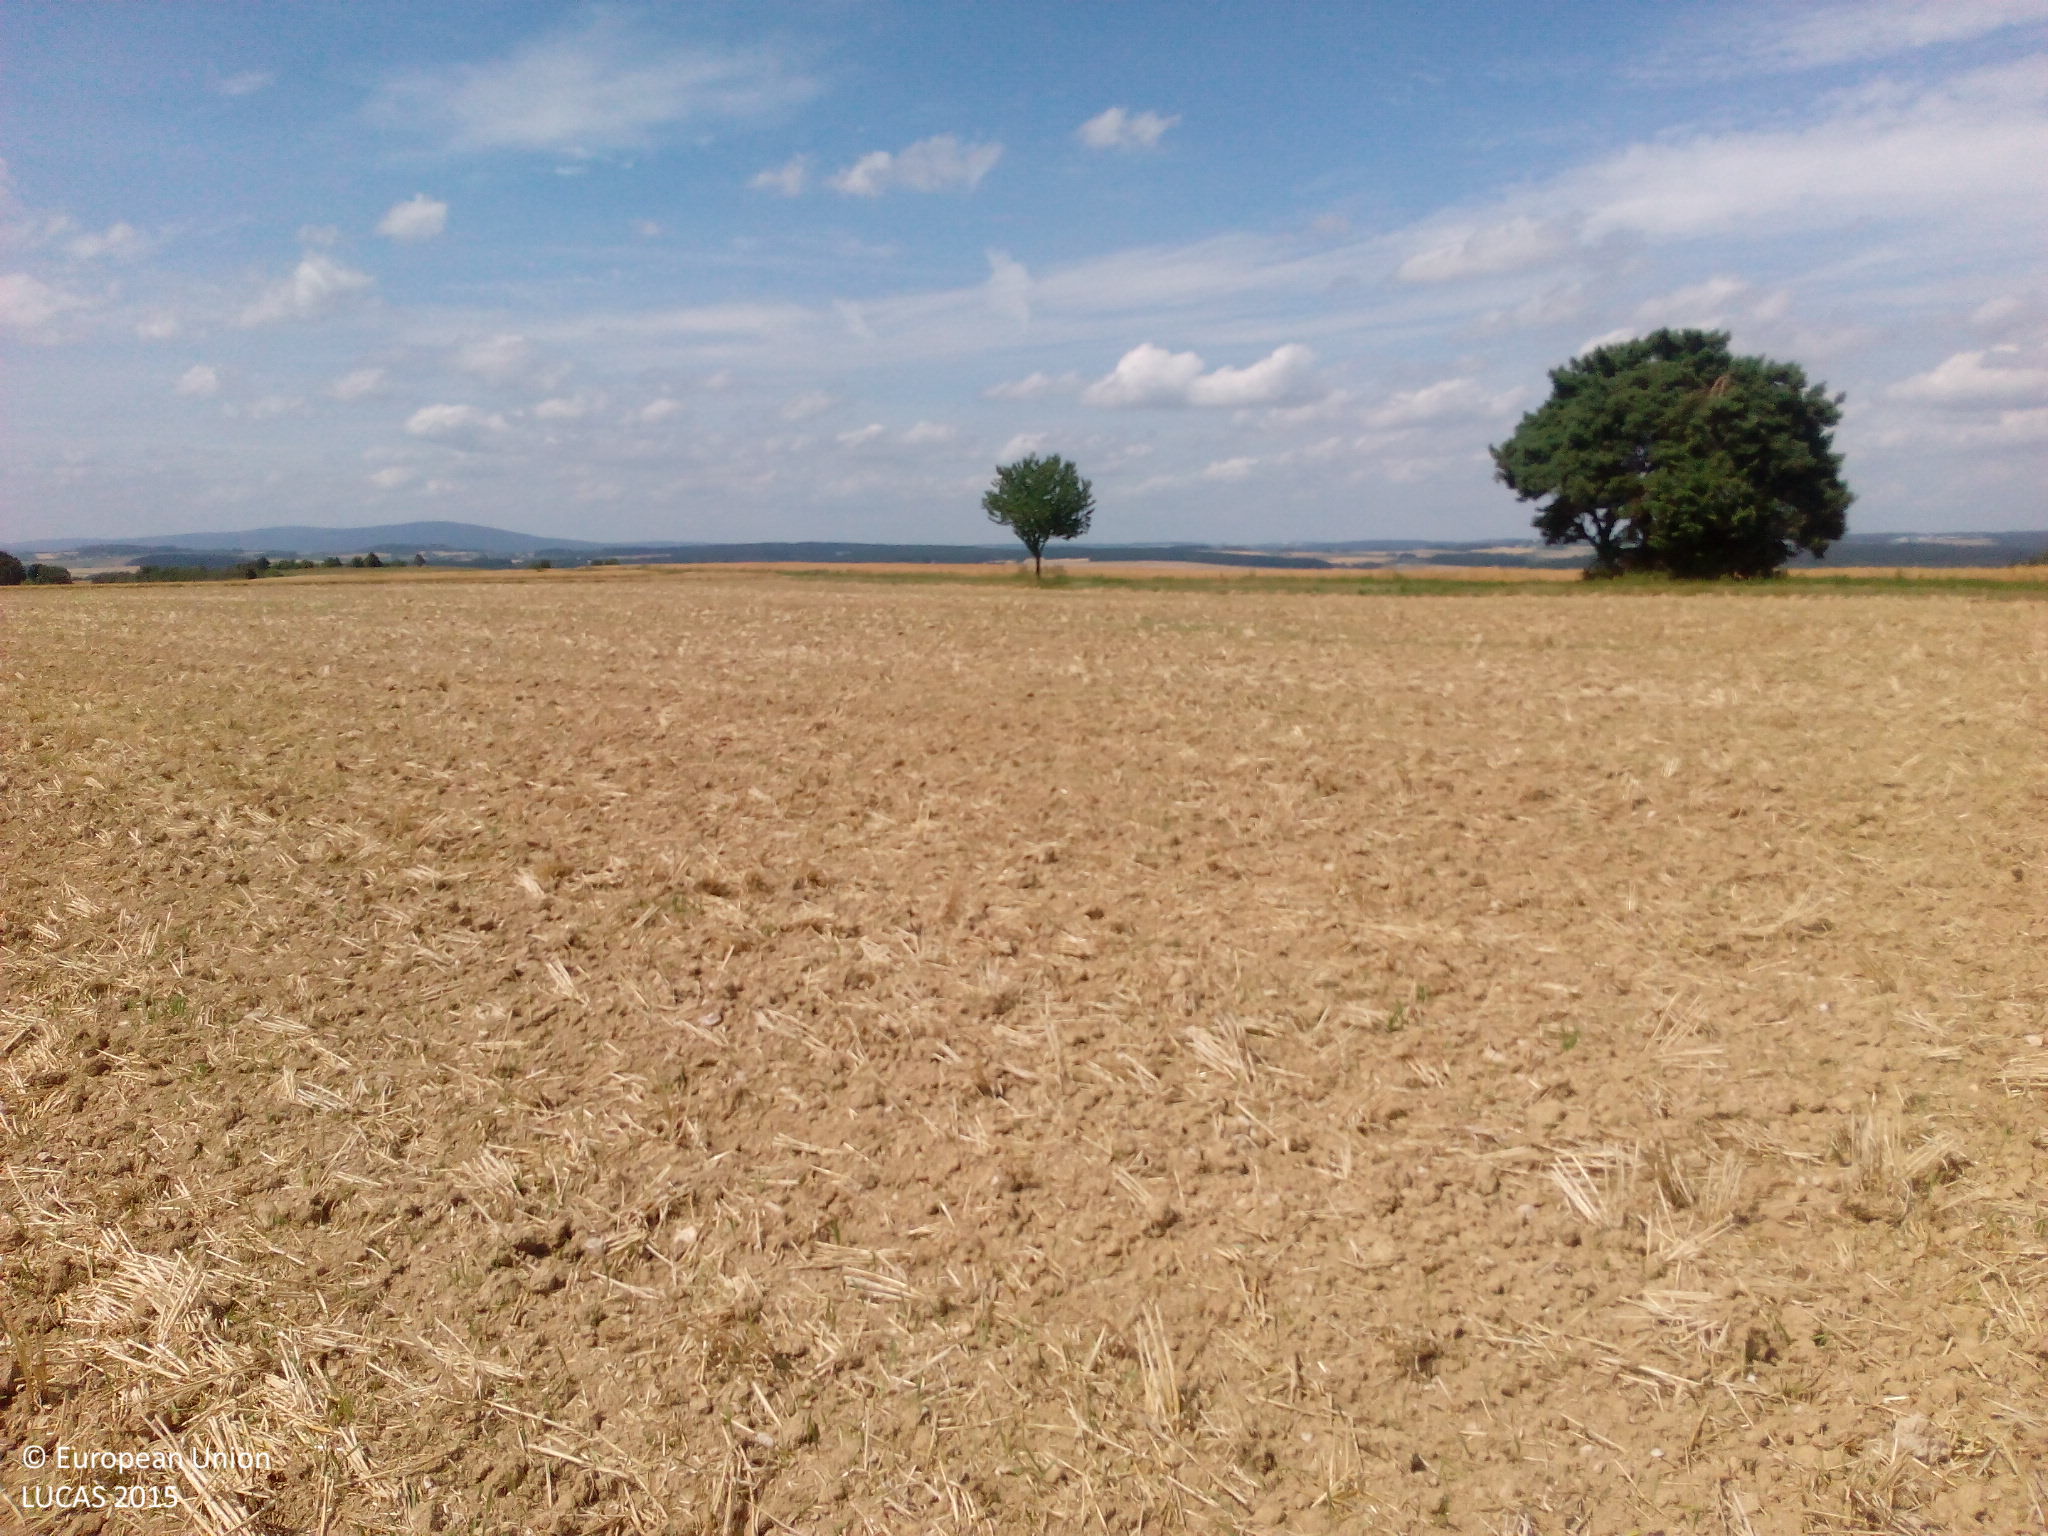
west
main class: Cropland
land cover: Barley
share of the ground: < 10 %
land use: Agriculture (excluding fallow land and kitchen gardens)
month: July
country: DE
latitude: 49.9231
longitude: 7.5071
